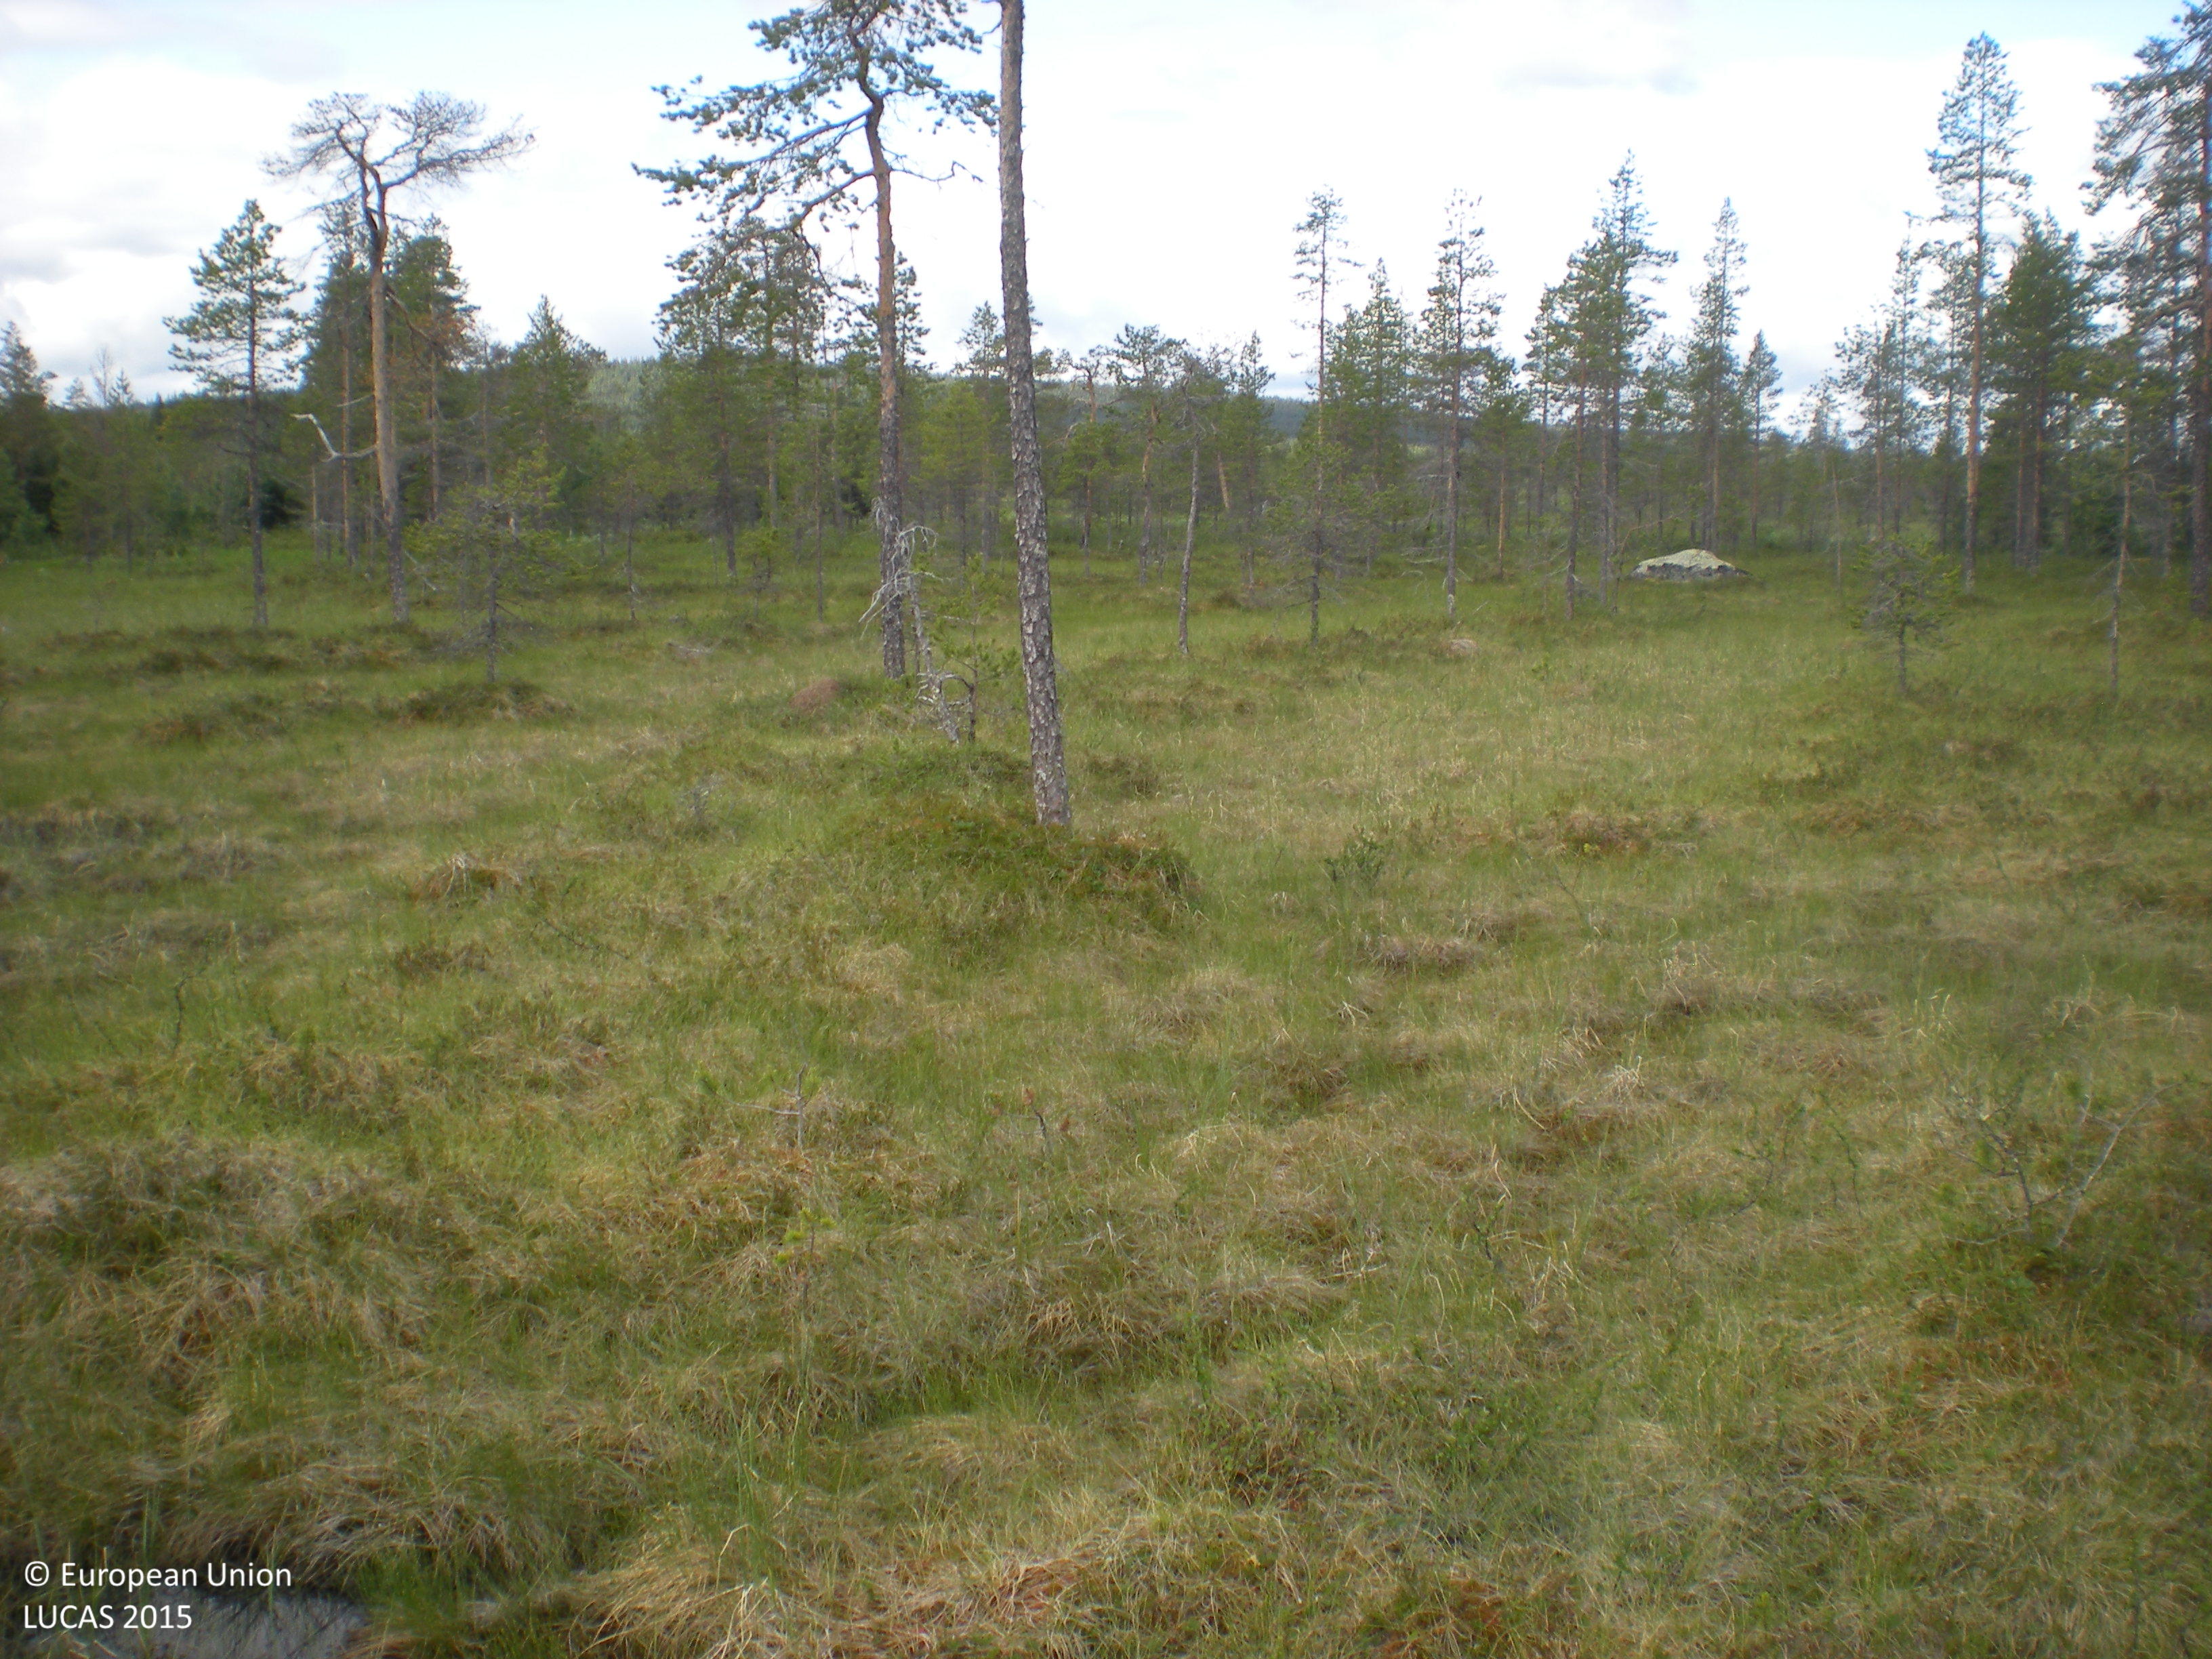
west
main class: Woodland
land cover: Pine dominated coniferous woodland
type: mire and swamp forests
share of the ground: 10 - 25 %
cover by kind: herbaceous plants 60 %, lichens and mosses 20 %, coniferous forest trees 15 %, shrubs 5 %
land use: Semi-natural and natural areas not in use
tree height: < 5 m
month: July
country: SE
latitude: 65.6851
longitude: 18.0331
